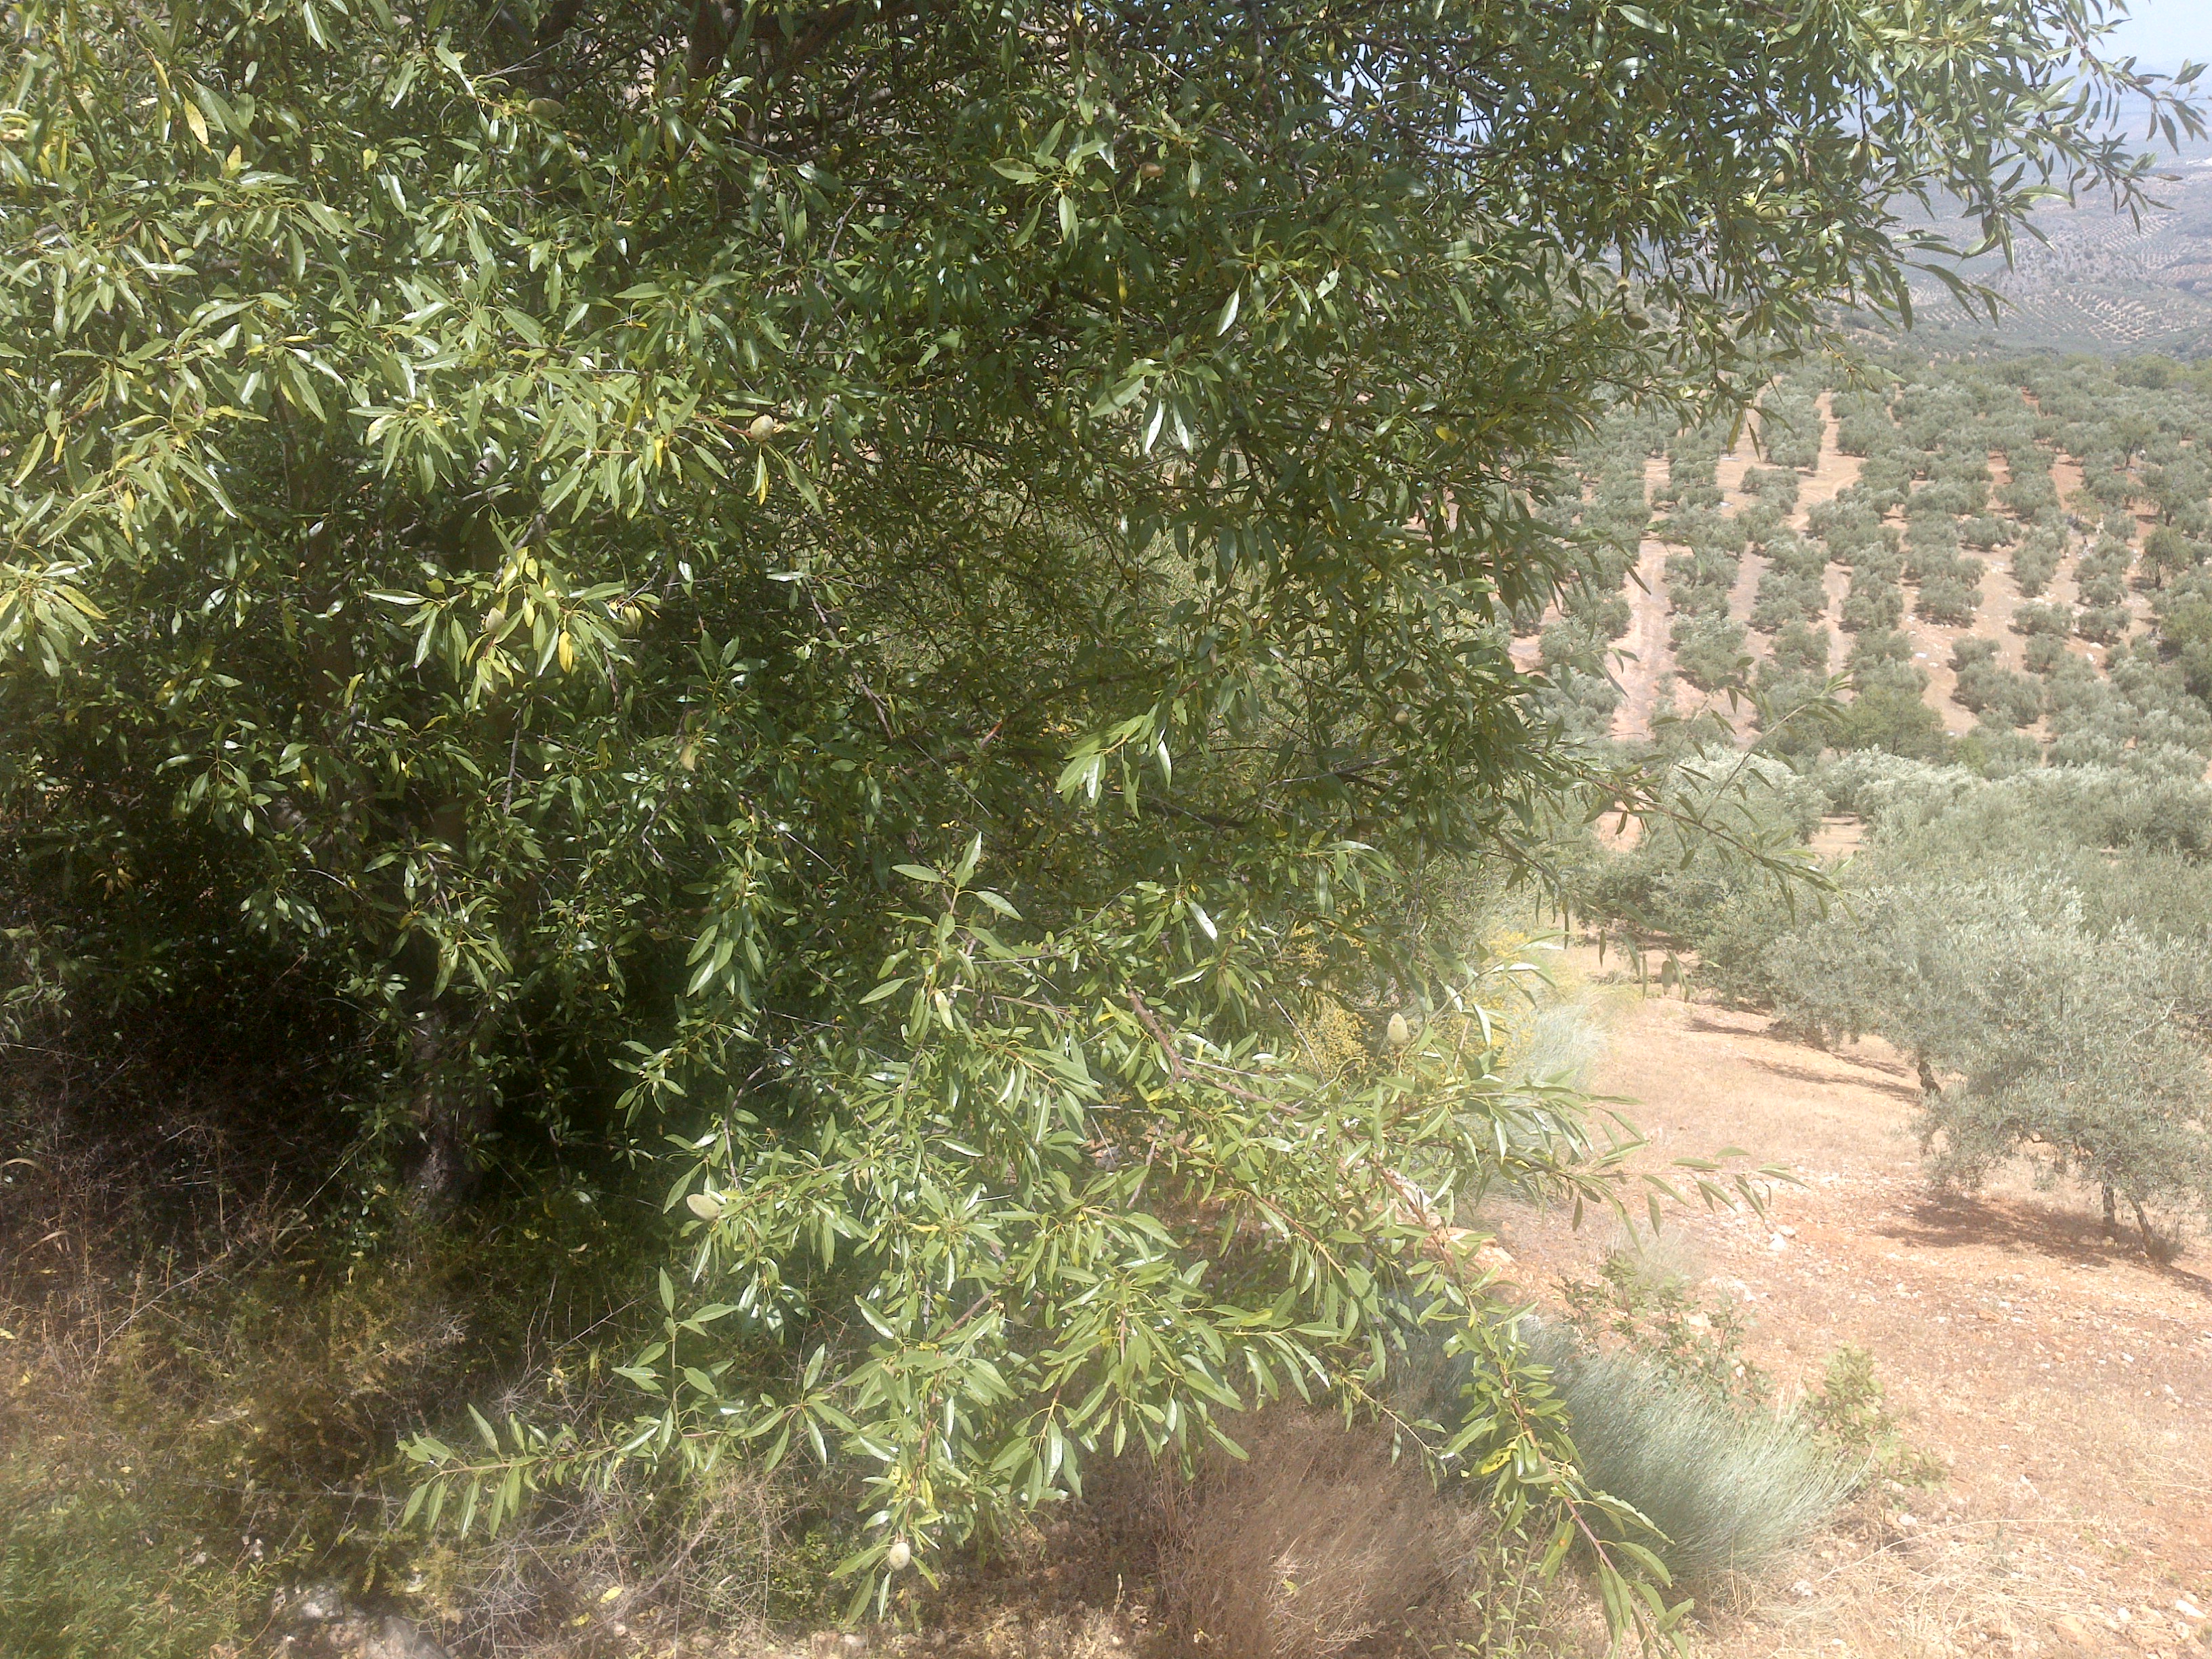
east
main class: Shrubland
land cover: Shrubland with sparse tree cover
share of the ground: 25 - 50 %
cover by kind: herbaceous plants 50 %, shrubs 25 %, unconsolidated bare surface 20 %, broadleaved forest trees 5 %
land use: Semi-natural and natural areas not in use
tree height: < 5 m
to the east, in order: Shrubland with sparse tree cover; Olive groves; Tracks; Olive groves; Rock outcrops; Single bushes/trees; Olive groves; Tracks; Olive groves
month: May
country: ES
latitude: 37.4968
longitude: -4.2418
